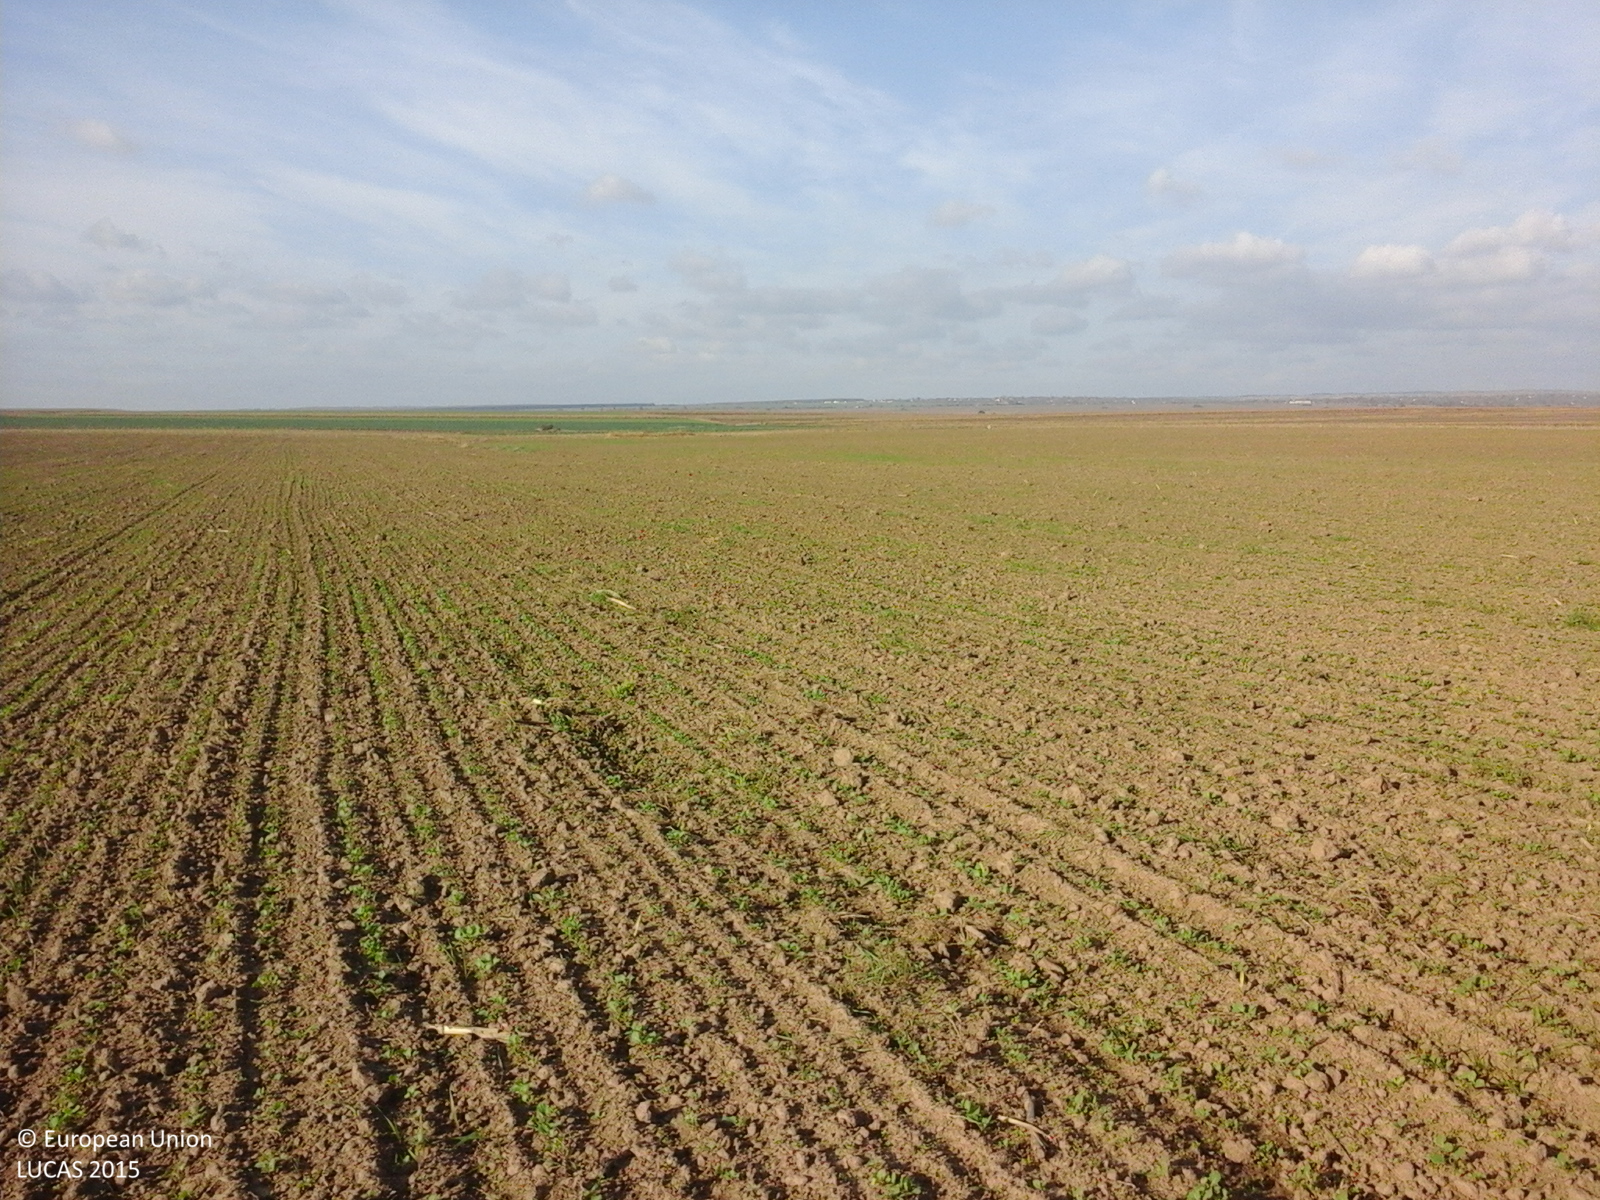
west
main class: Cropland
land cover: Rape and turnip rape
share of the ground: < 10 %
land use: Agriculture (excluding fallow land and kitchen gardens)
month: October
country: RO
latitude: 46.0141
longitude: 27.1849
